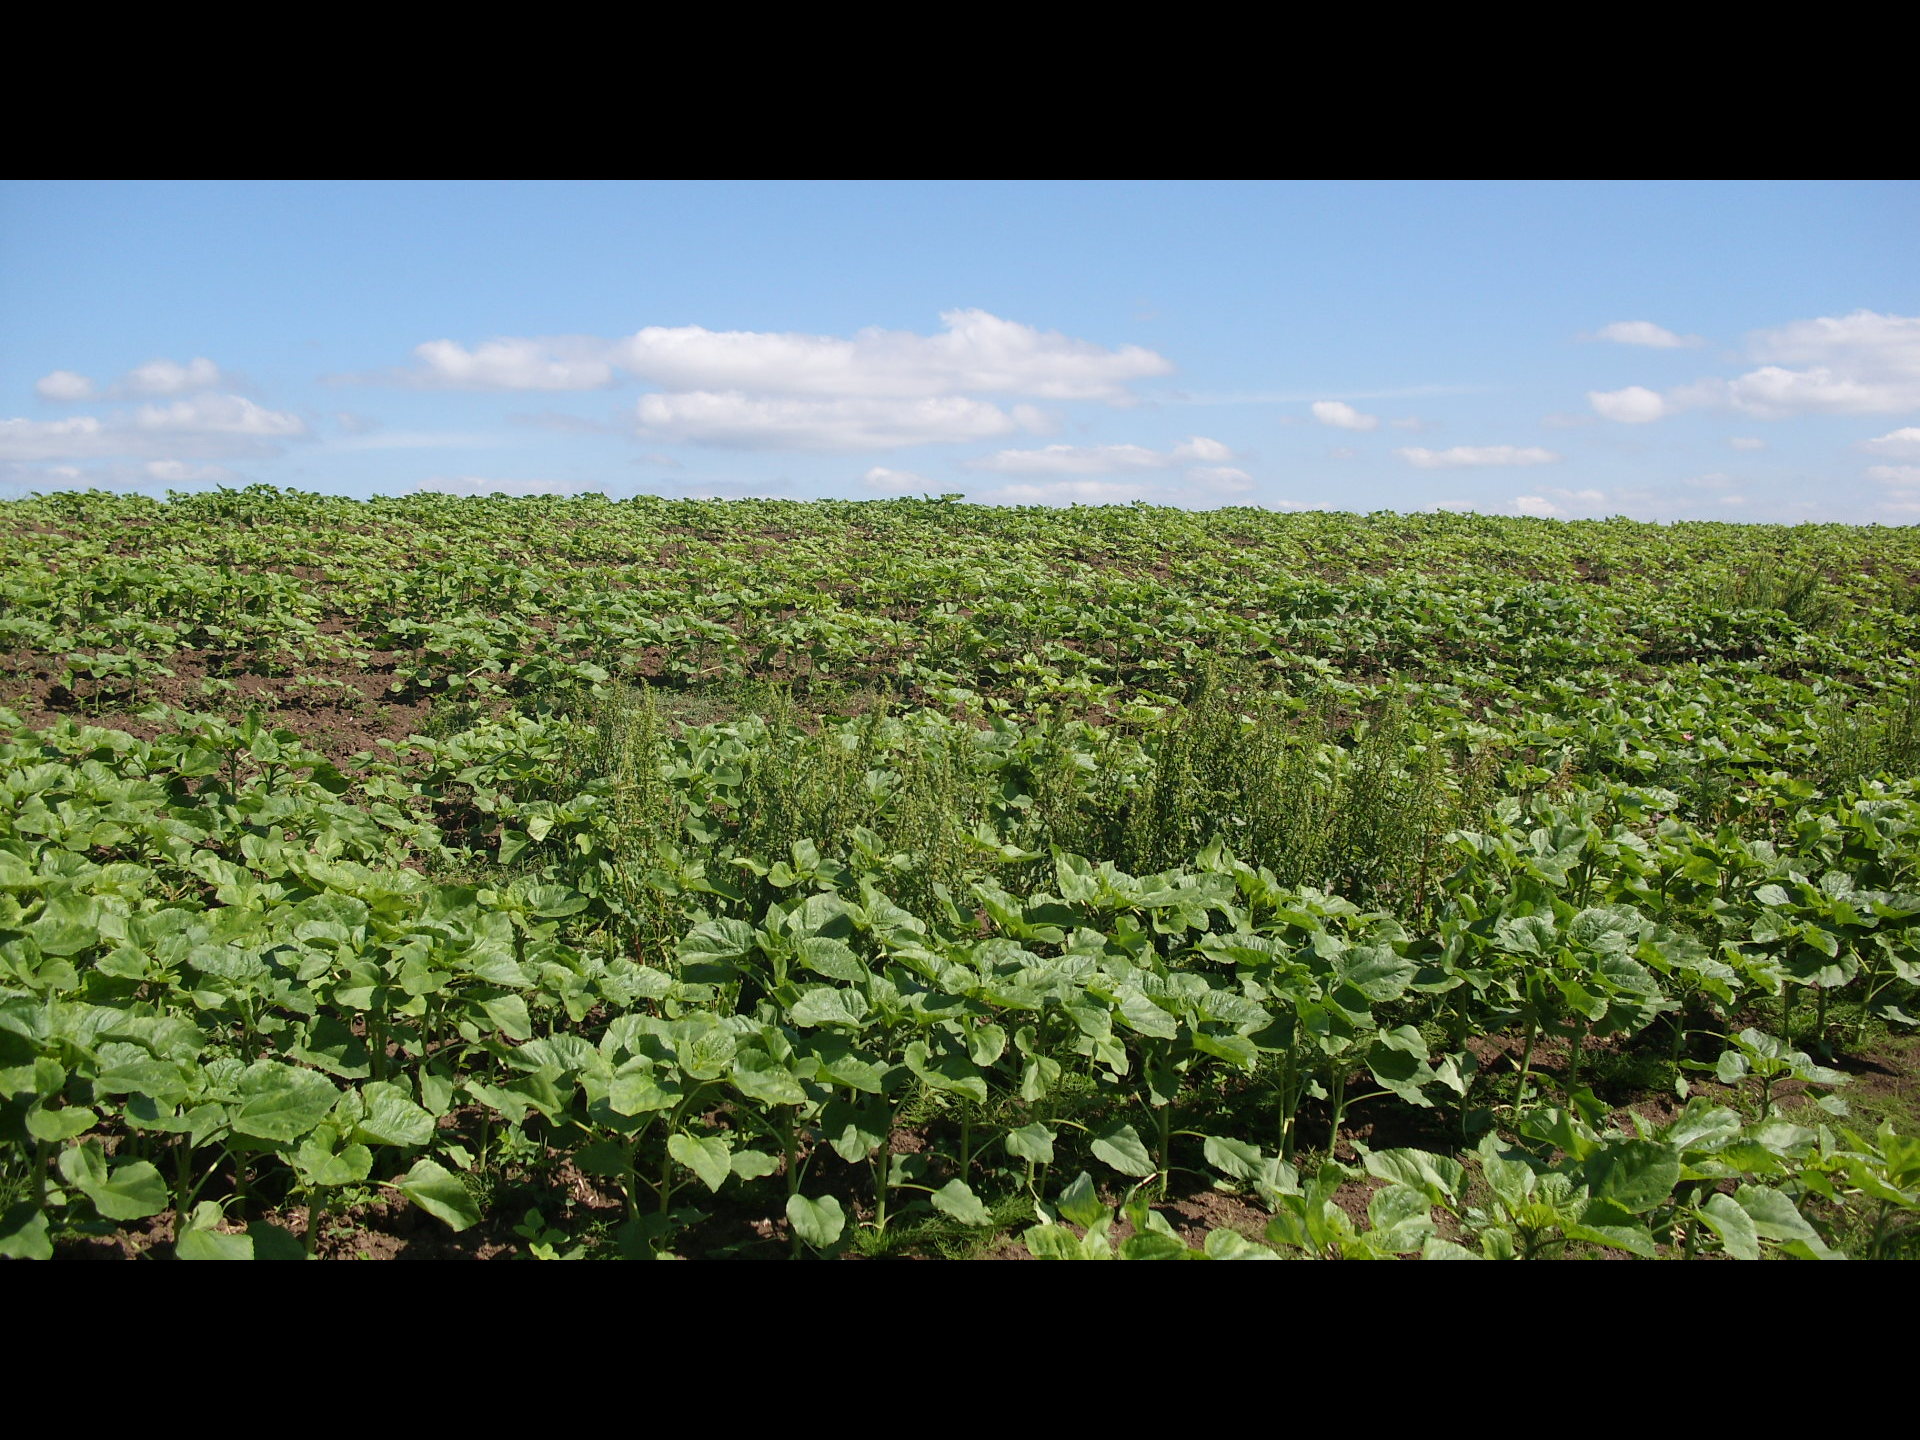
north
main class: Cropland
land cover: Sunflower
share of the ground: > 75 %
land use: Agriculture (excluding fallow land and kitchen gardens)
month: May
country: BG
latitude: 43.3987
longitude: 23.4391
